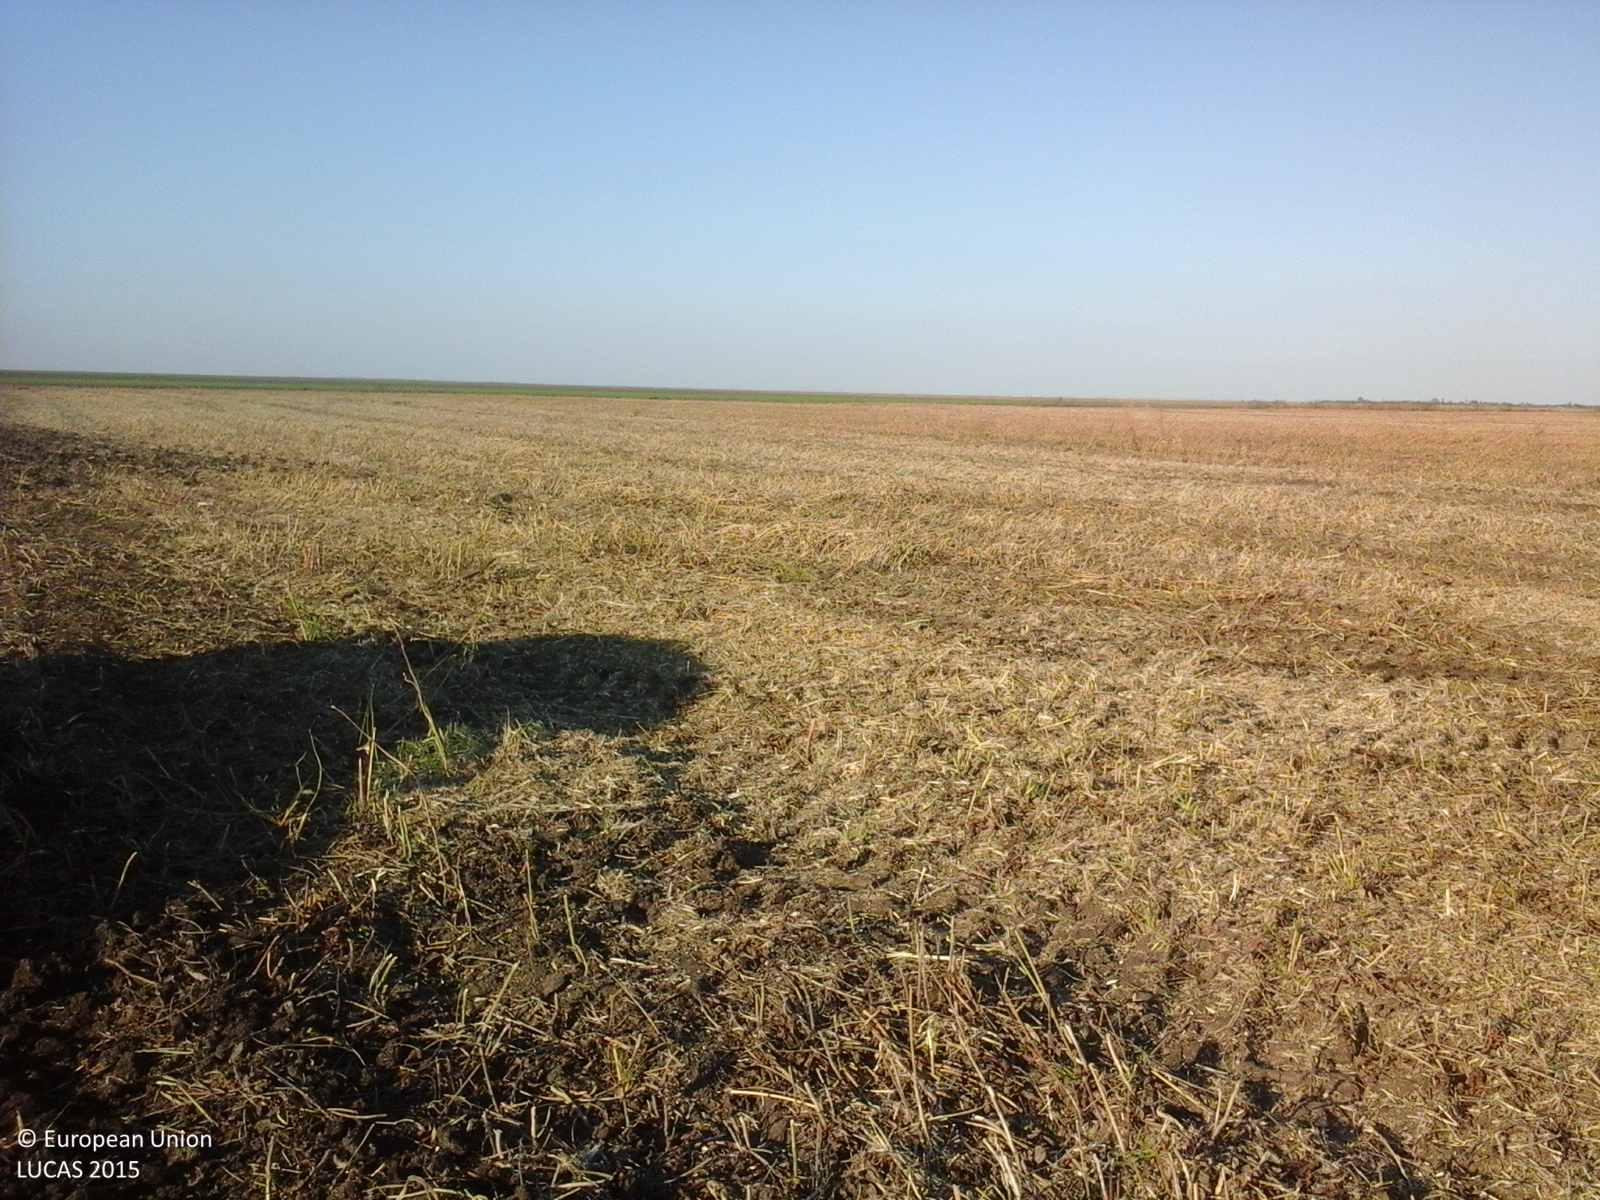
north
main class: Cropland
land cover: Soya
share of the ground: 25 - 50 %
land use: Agriculture (excluding fallow land and kitchen gardens)
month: October
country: RO
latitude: 45.3670
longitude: 27.4246
